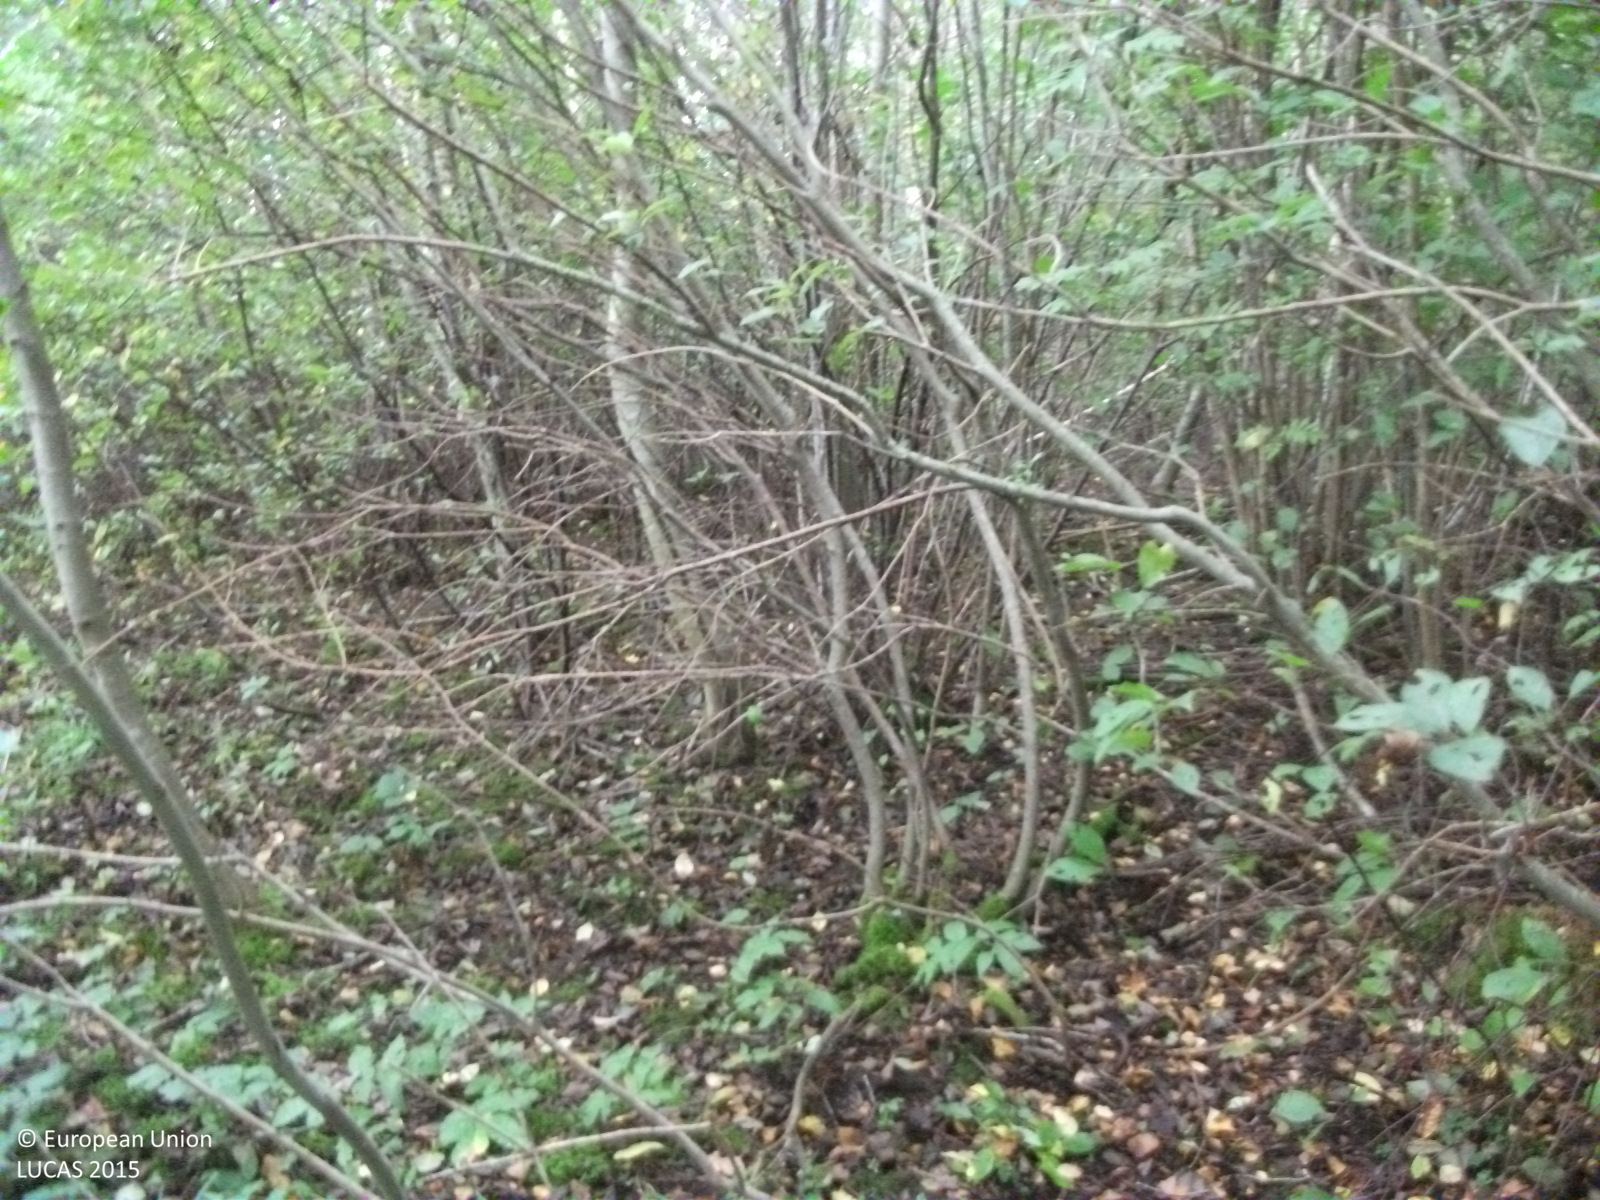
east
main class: Woodland
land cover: Broadleaved woodland
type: non-riverine alder, birch or aspen forest
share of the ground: > 75 %
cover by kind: broadleaved forest trees 80 %, herbaceous plants 10 %, shrubs 5 %, unconsolidated bare surface 5 %
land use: Forestry
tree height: > 5 m
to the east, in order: Broadleaved woodland; Fences; Grassland without tree/shrub cover; Fences; Grass margins; Paved roads, cycling and walking lanes; Grassland without tree/shrub cover; Electric lines; Grassland without tree/shrub cover; Other leguminous and mixtures for fodder
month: September
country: LV
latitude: 57.4618
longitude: 24.6814
